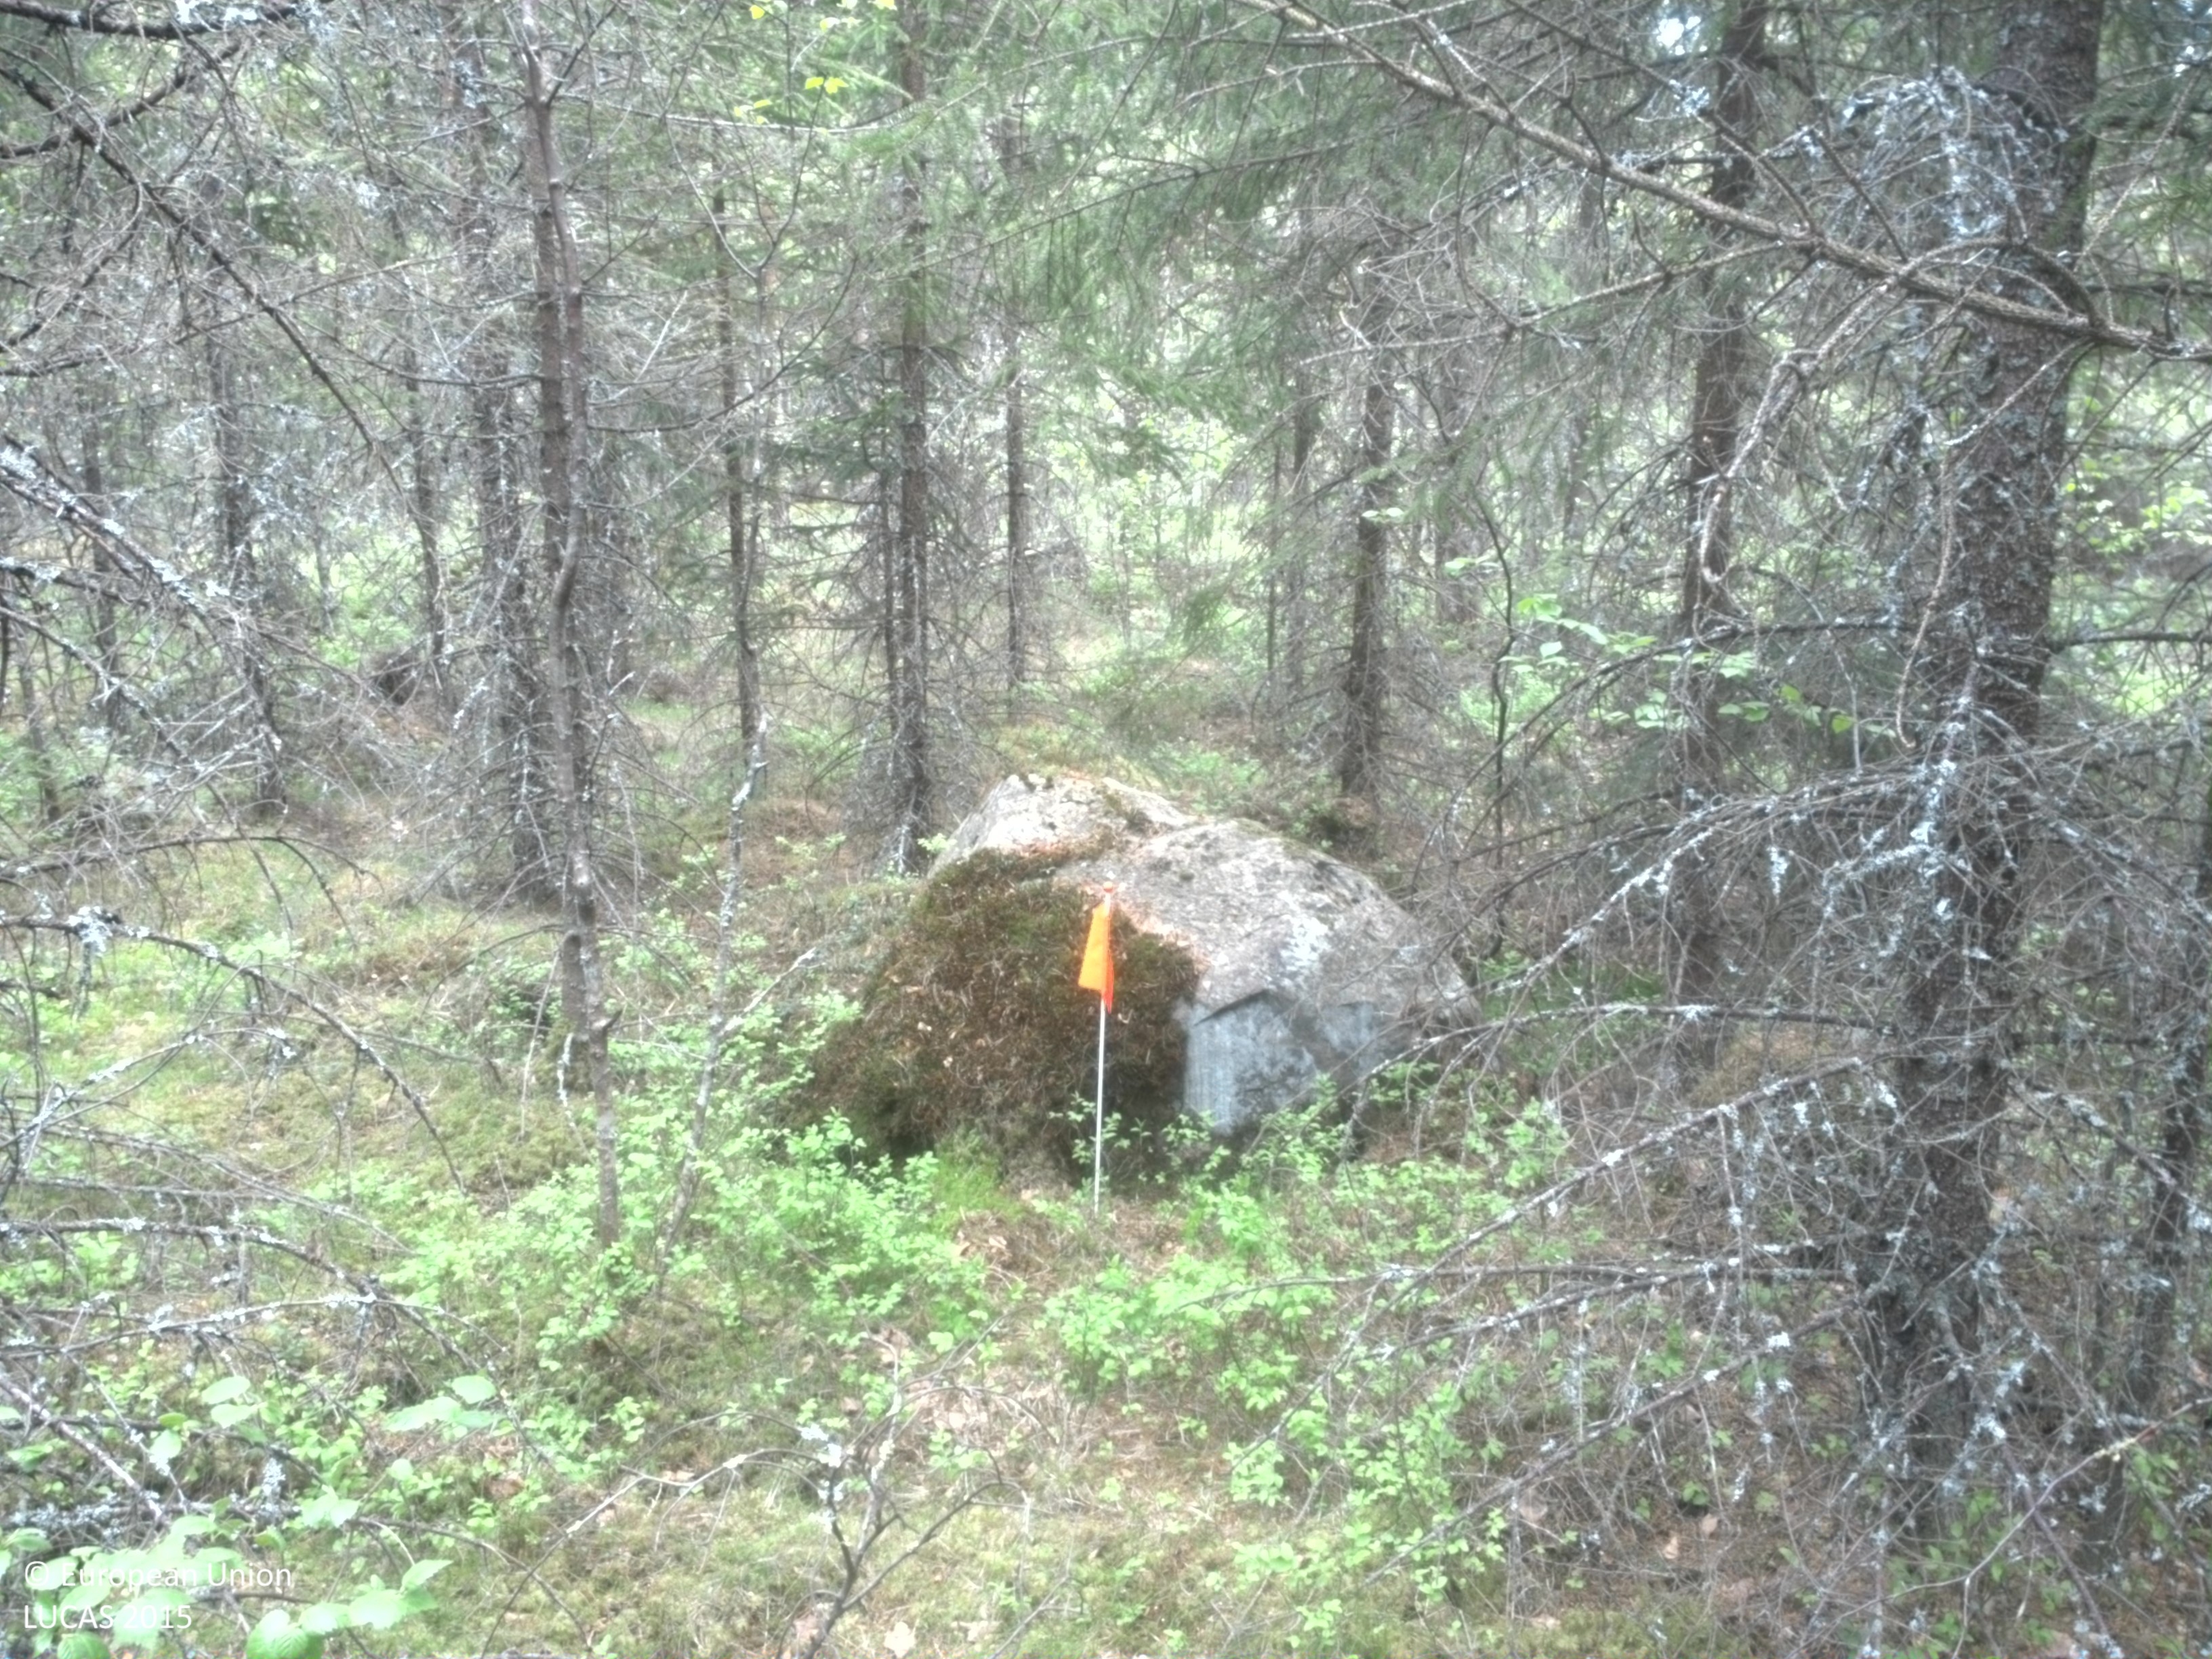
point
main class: Woodland
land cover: Spruce dominated coniferous woodland
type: boreal forest
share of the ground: > 75 %
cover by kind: coniferous forest trees 65 %, broadleaved forest trees 10 %, shrubs 10 %, lichens and mosses 10 %, herbaceous plants 5 %
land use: Forestry
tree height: > 5 m
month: June
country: SE
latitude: 59.5260
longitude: 14.1101
